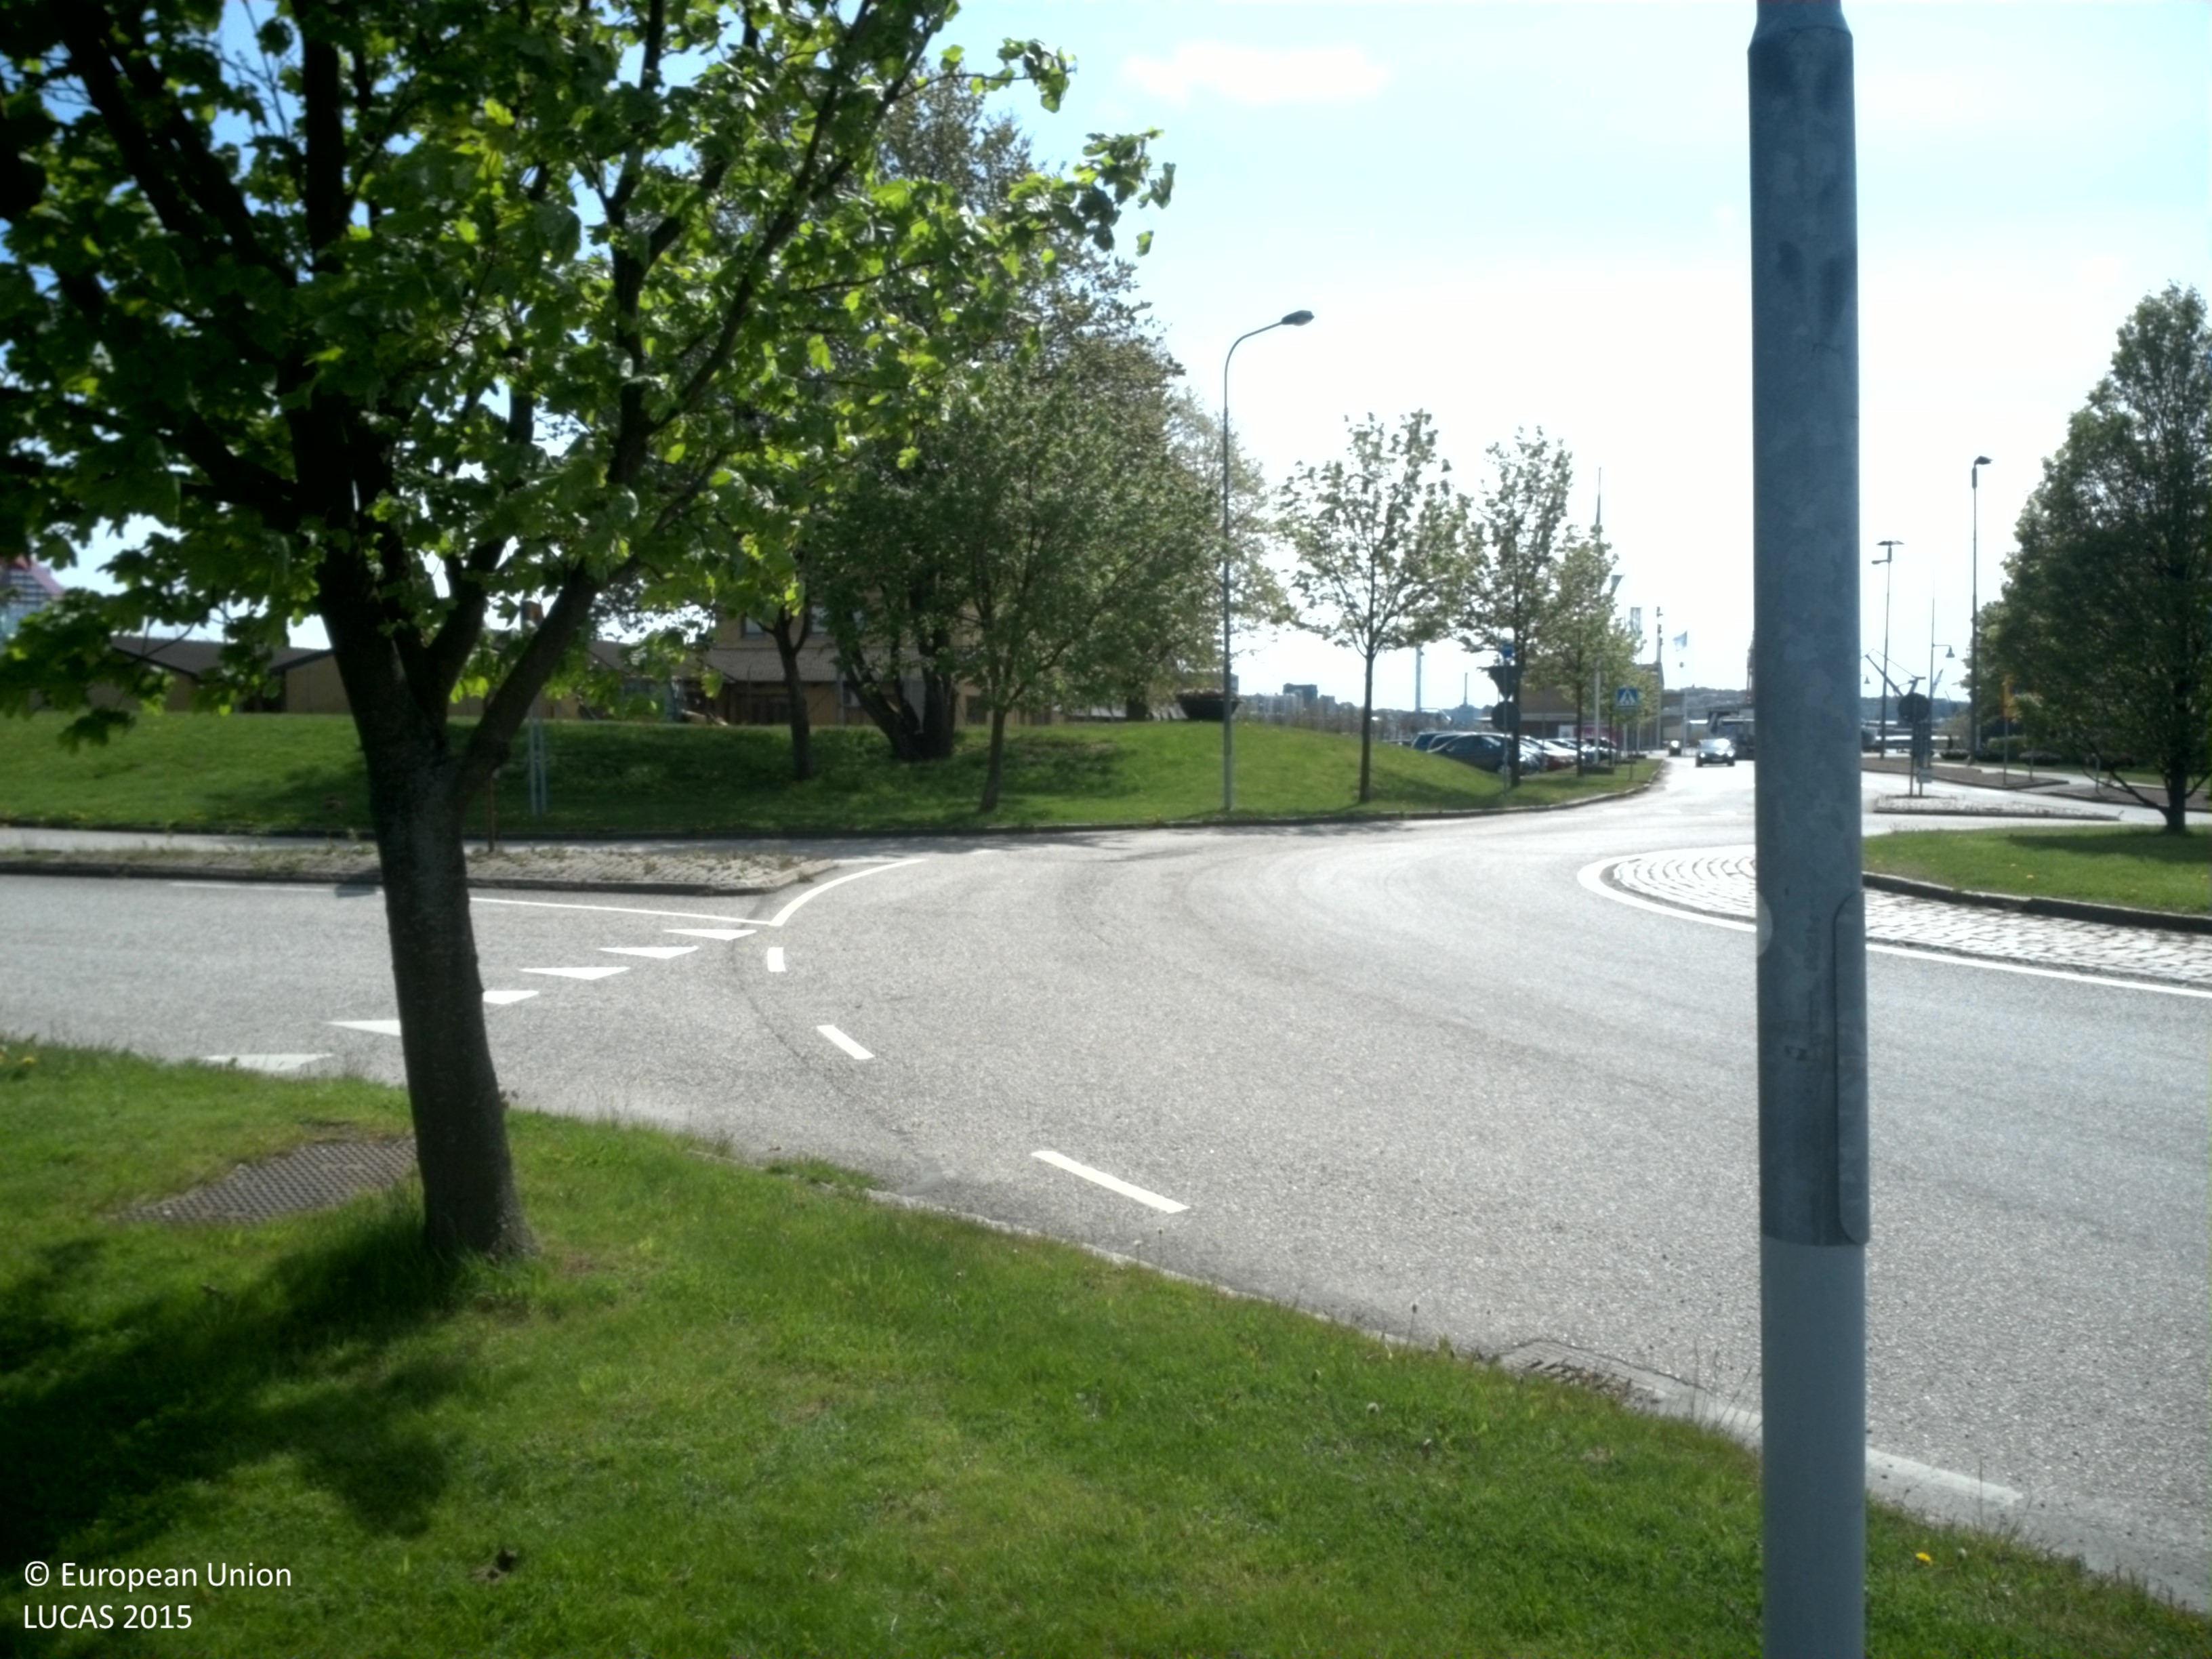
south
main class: Grassland
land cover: Grassland with sparse tree/shrub cover
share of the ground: > 75 %
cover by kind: herbaceous plants 95 %, broadleaved forest trees 5 %
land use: Road transport
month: May
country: SE
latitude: 57.7195
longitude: 11.9609
